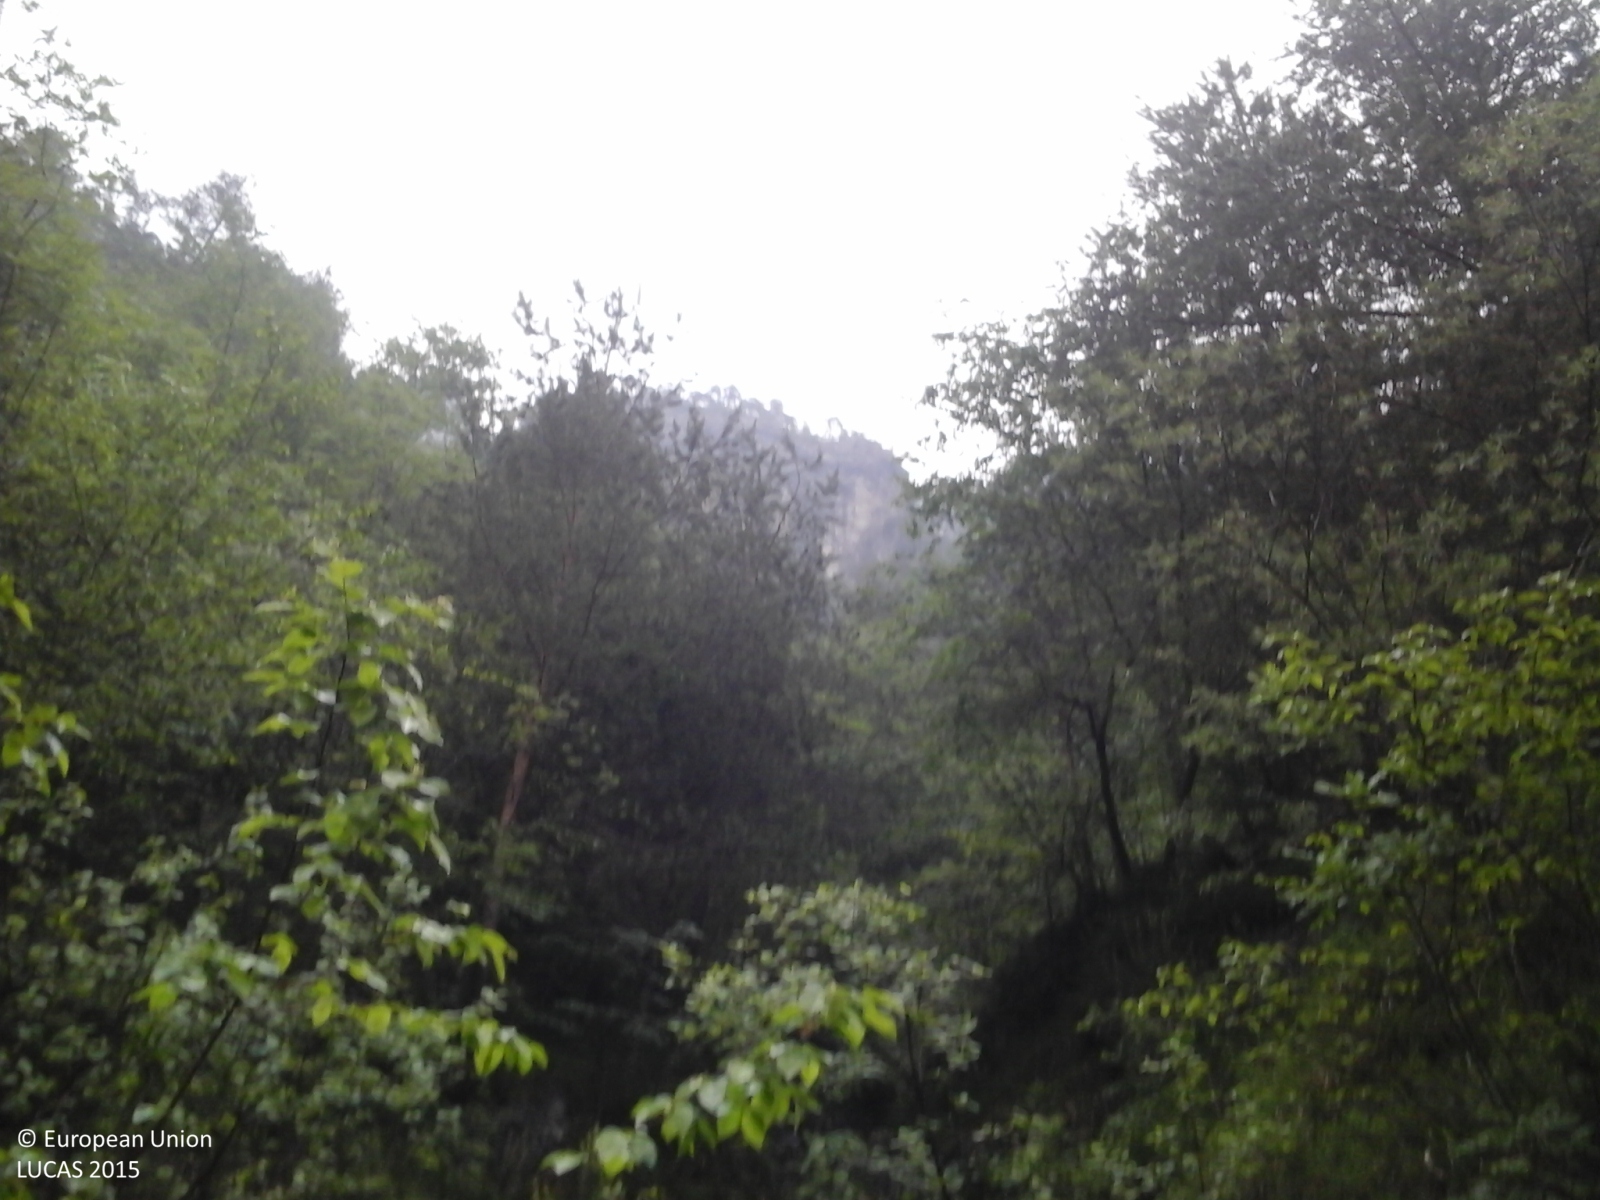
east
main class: Woodland
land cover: Pine dominated coniferous woodland
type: alpine coniferous forest
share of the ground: > 75 %
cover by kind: coniferous forest trees 100 %
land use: Forestry
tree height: > 5 m
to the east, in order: Pine dominated coniferous woodland
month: May
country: IT
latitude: 46.1208
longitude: 11.7446
